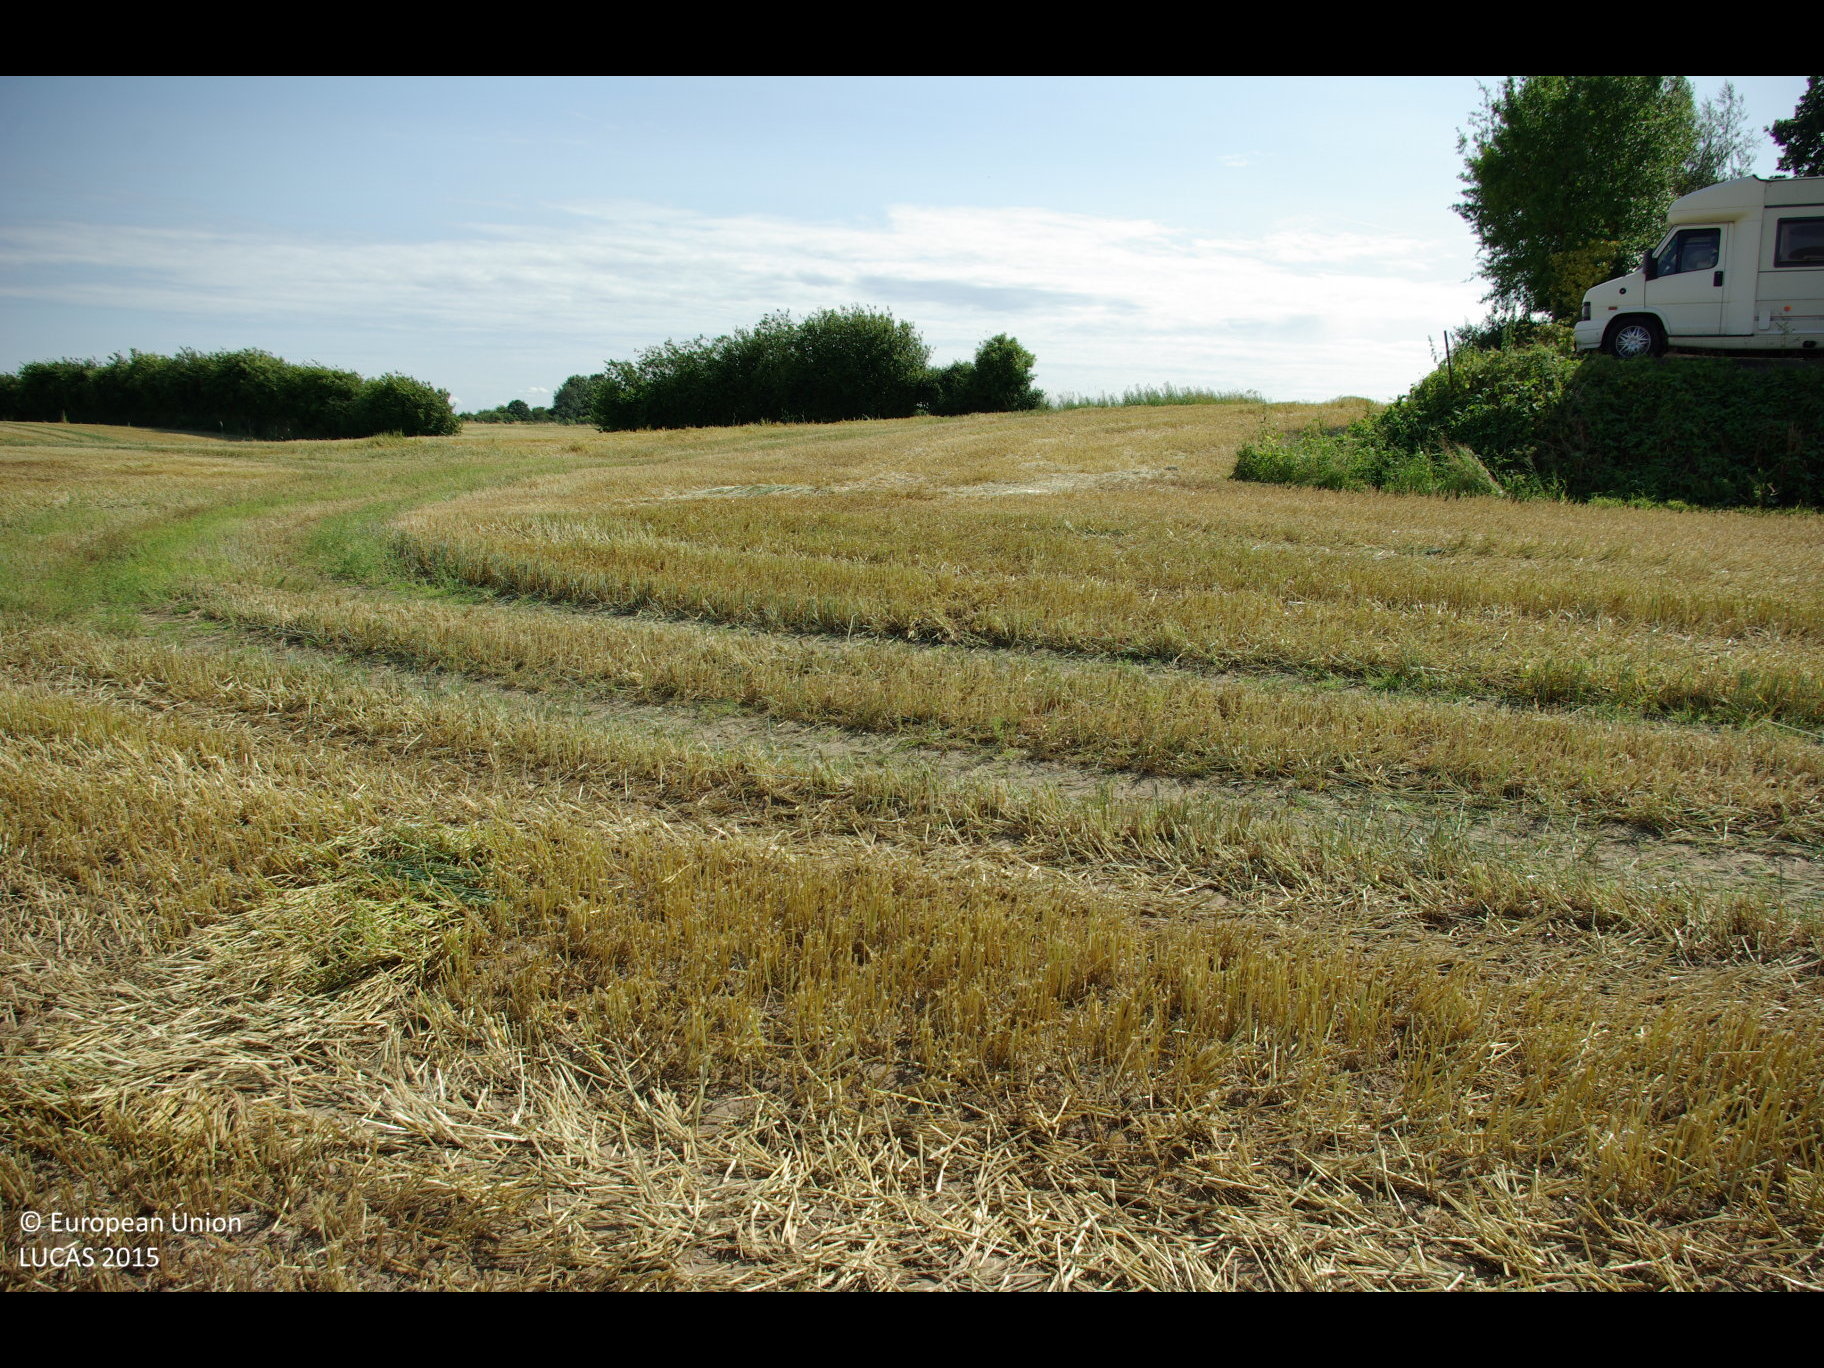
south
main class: Cropland
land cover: Rye
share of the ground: 10 - 25 %
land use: Agriculture (excluding fallow land and kitchen gardens)
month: July
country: DE
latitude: 54.6232
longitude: 9.5512
